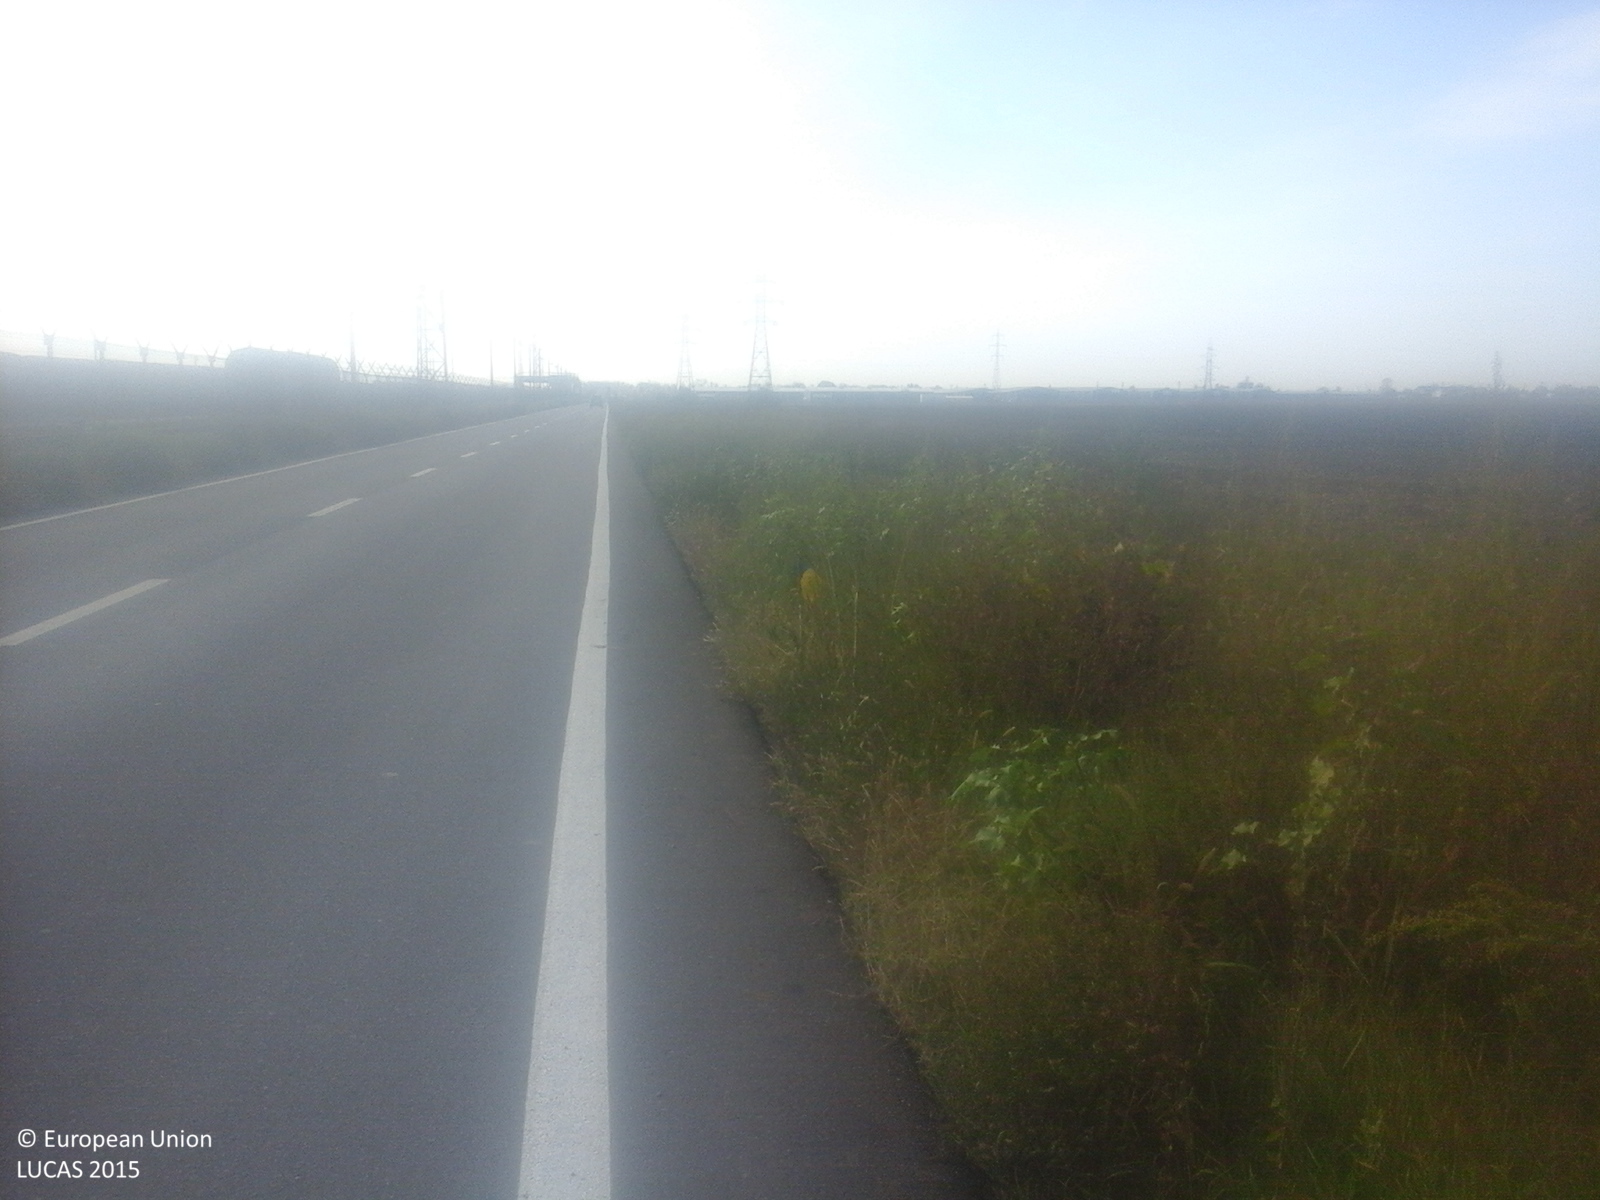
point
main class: Grassland
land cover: Spontaneously vegetated surfaces
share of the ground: > 75 %
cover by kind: herbaceous plants 100 %
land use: Fallow land
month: October
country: RO
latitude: 44.8807
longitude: 25.9948
